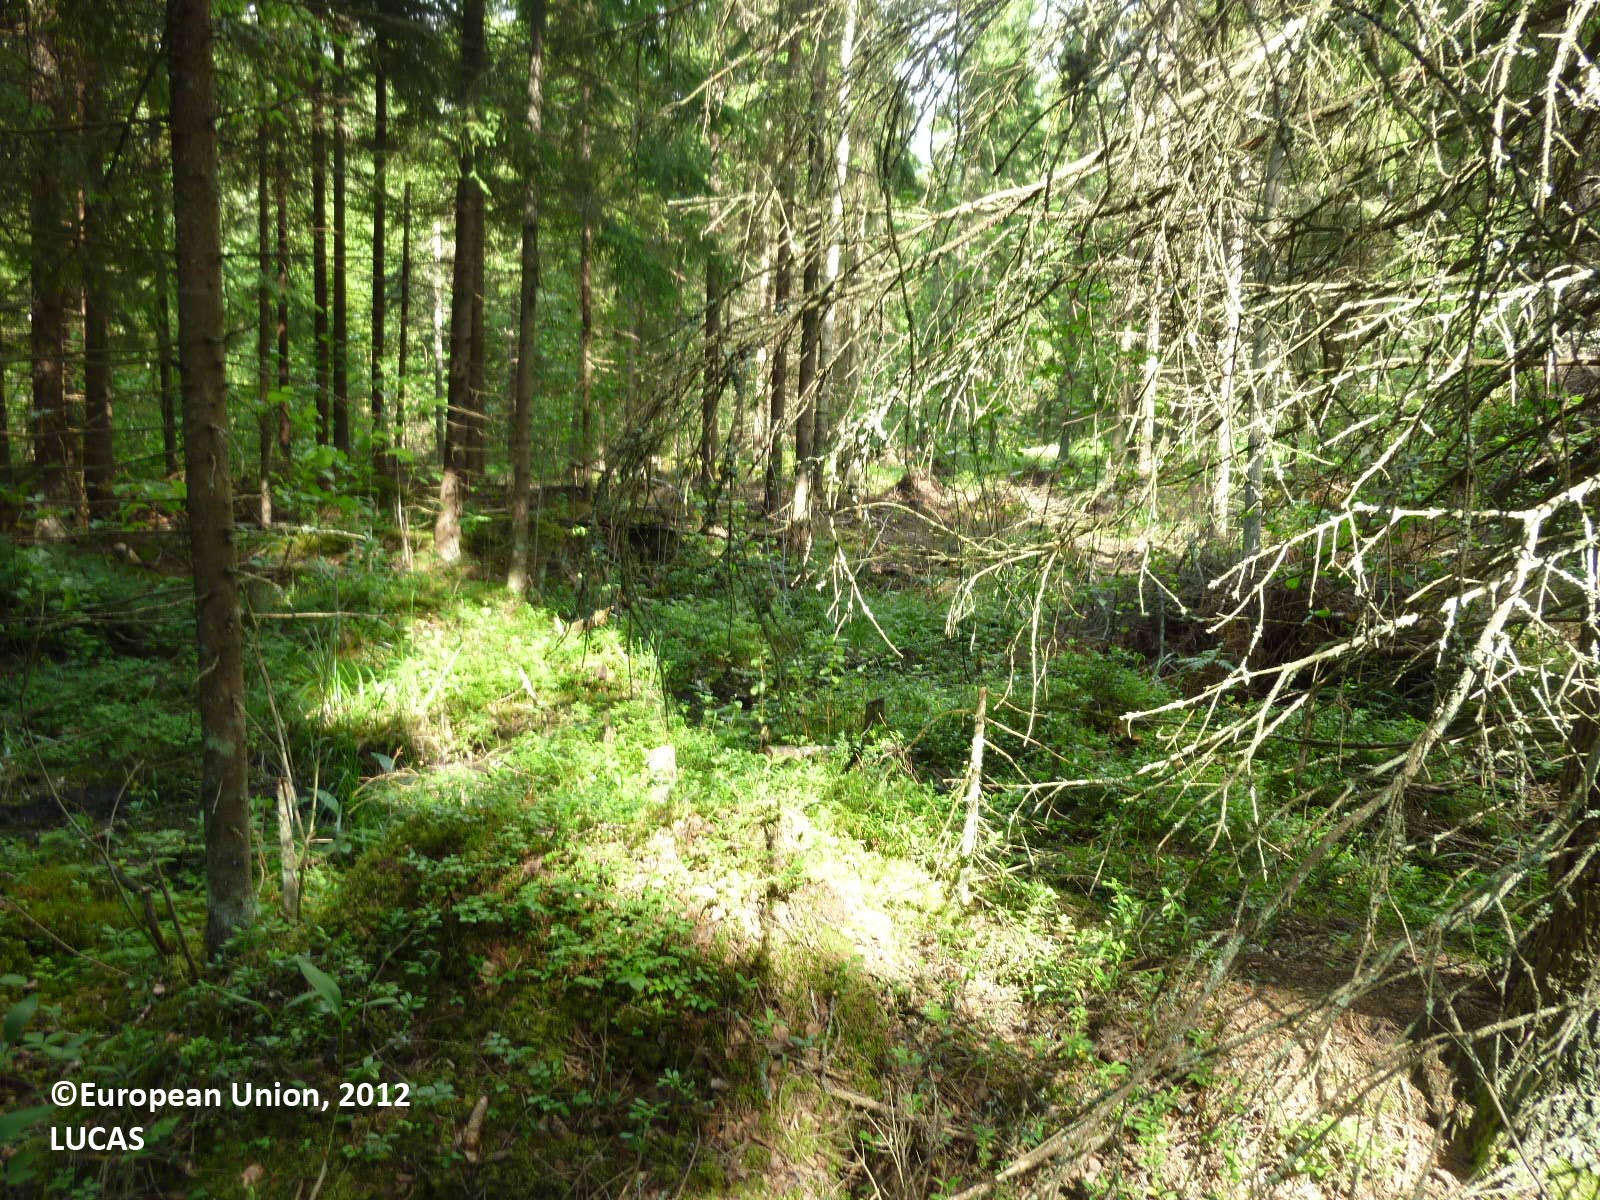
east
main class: Woodland
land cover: Spruce dominated mixed woodland
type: boreal forest
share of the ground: > 75 %
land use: Forestry
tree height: > 5 m
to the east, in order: Spruce dominated mixed woodland; Pine dominated coniferous woodland; Spruce dominated mixed woodland; Ditches and canals; Grassland with sparse tree/shrub cover; Paved roads, cycling and walking lanes; Grassland with sparse tree/shrub cover; Ditches and canals; Spruce dominated coniferous woodland; Ditches and canals; Spruce dominated mixed woodland
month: July
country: FI
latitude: 61.2563
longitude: 21.9696
